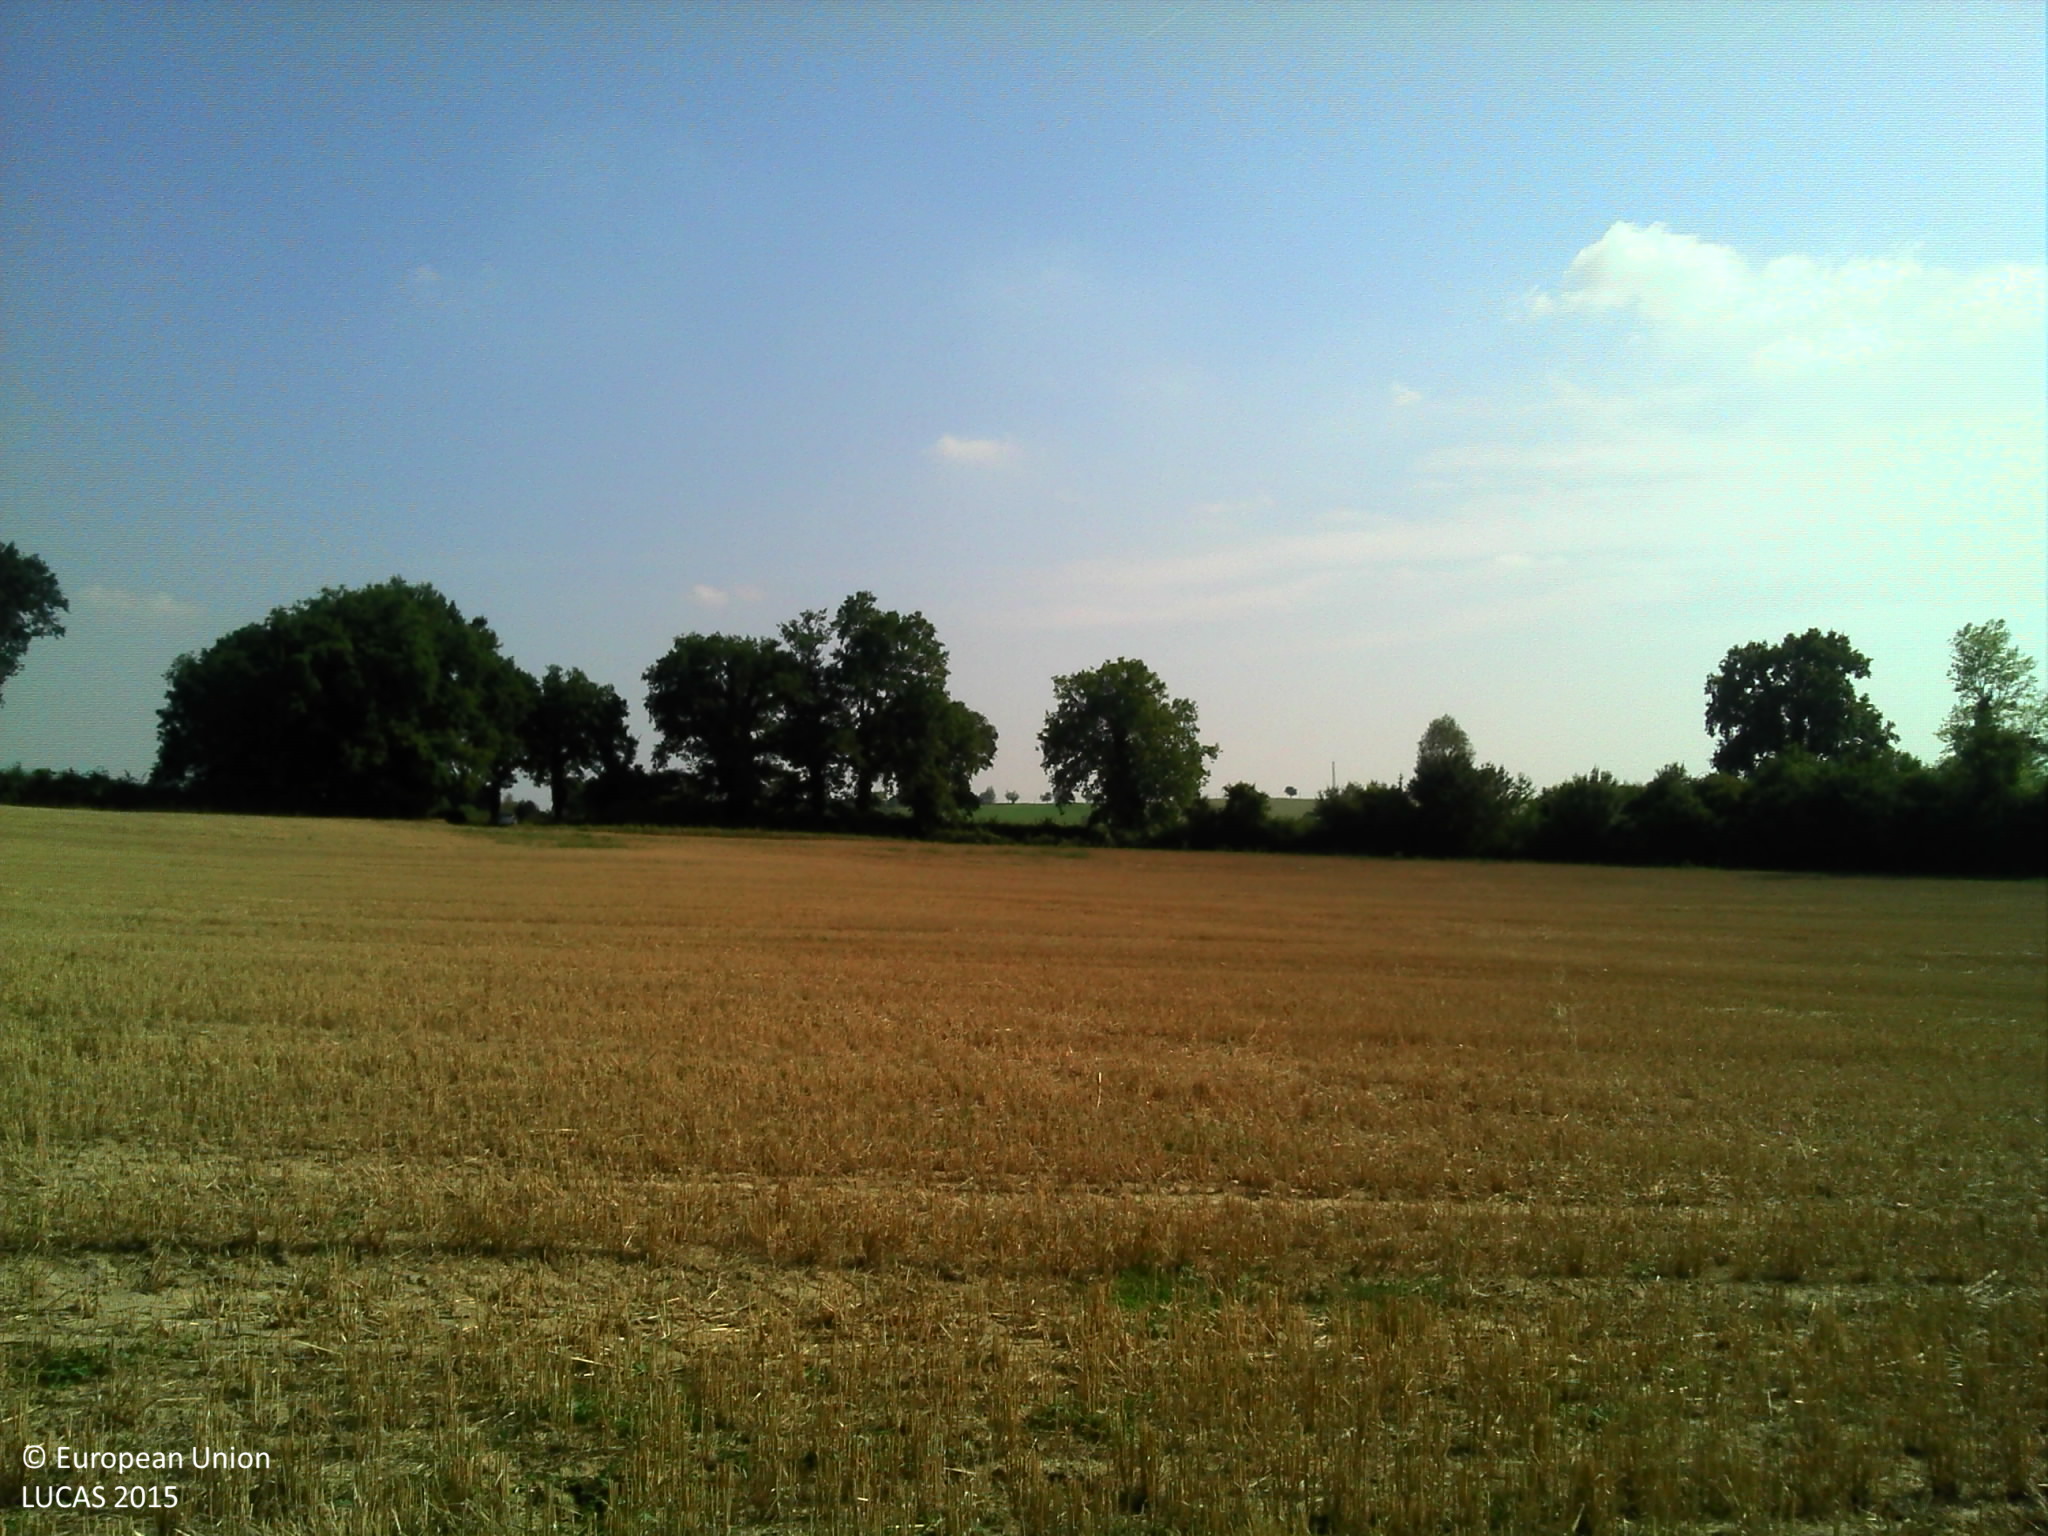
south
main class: Cropland
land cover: Common wheat
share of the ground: > 75 %
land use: Agriculture (excluding fallow land and kitchen gardens)
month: August
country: FR
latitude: 46.3952
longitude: 3.6139
